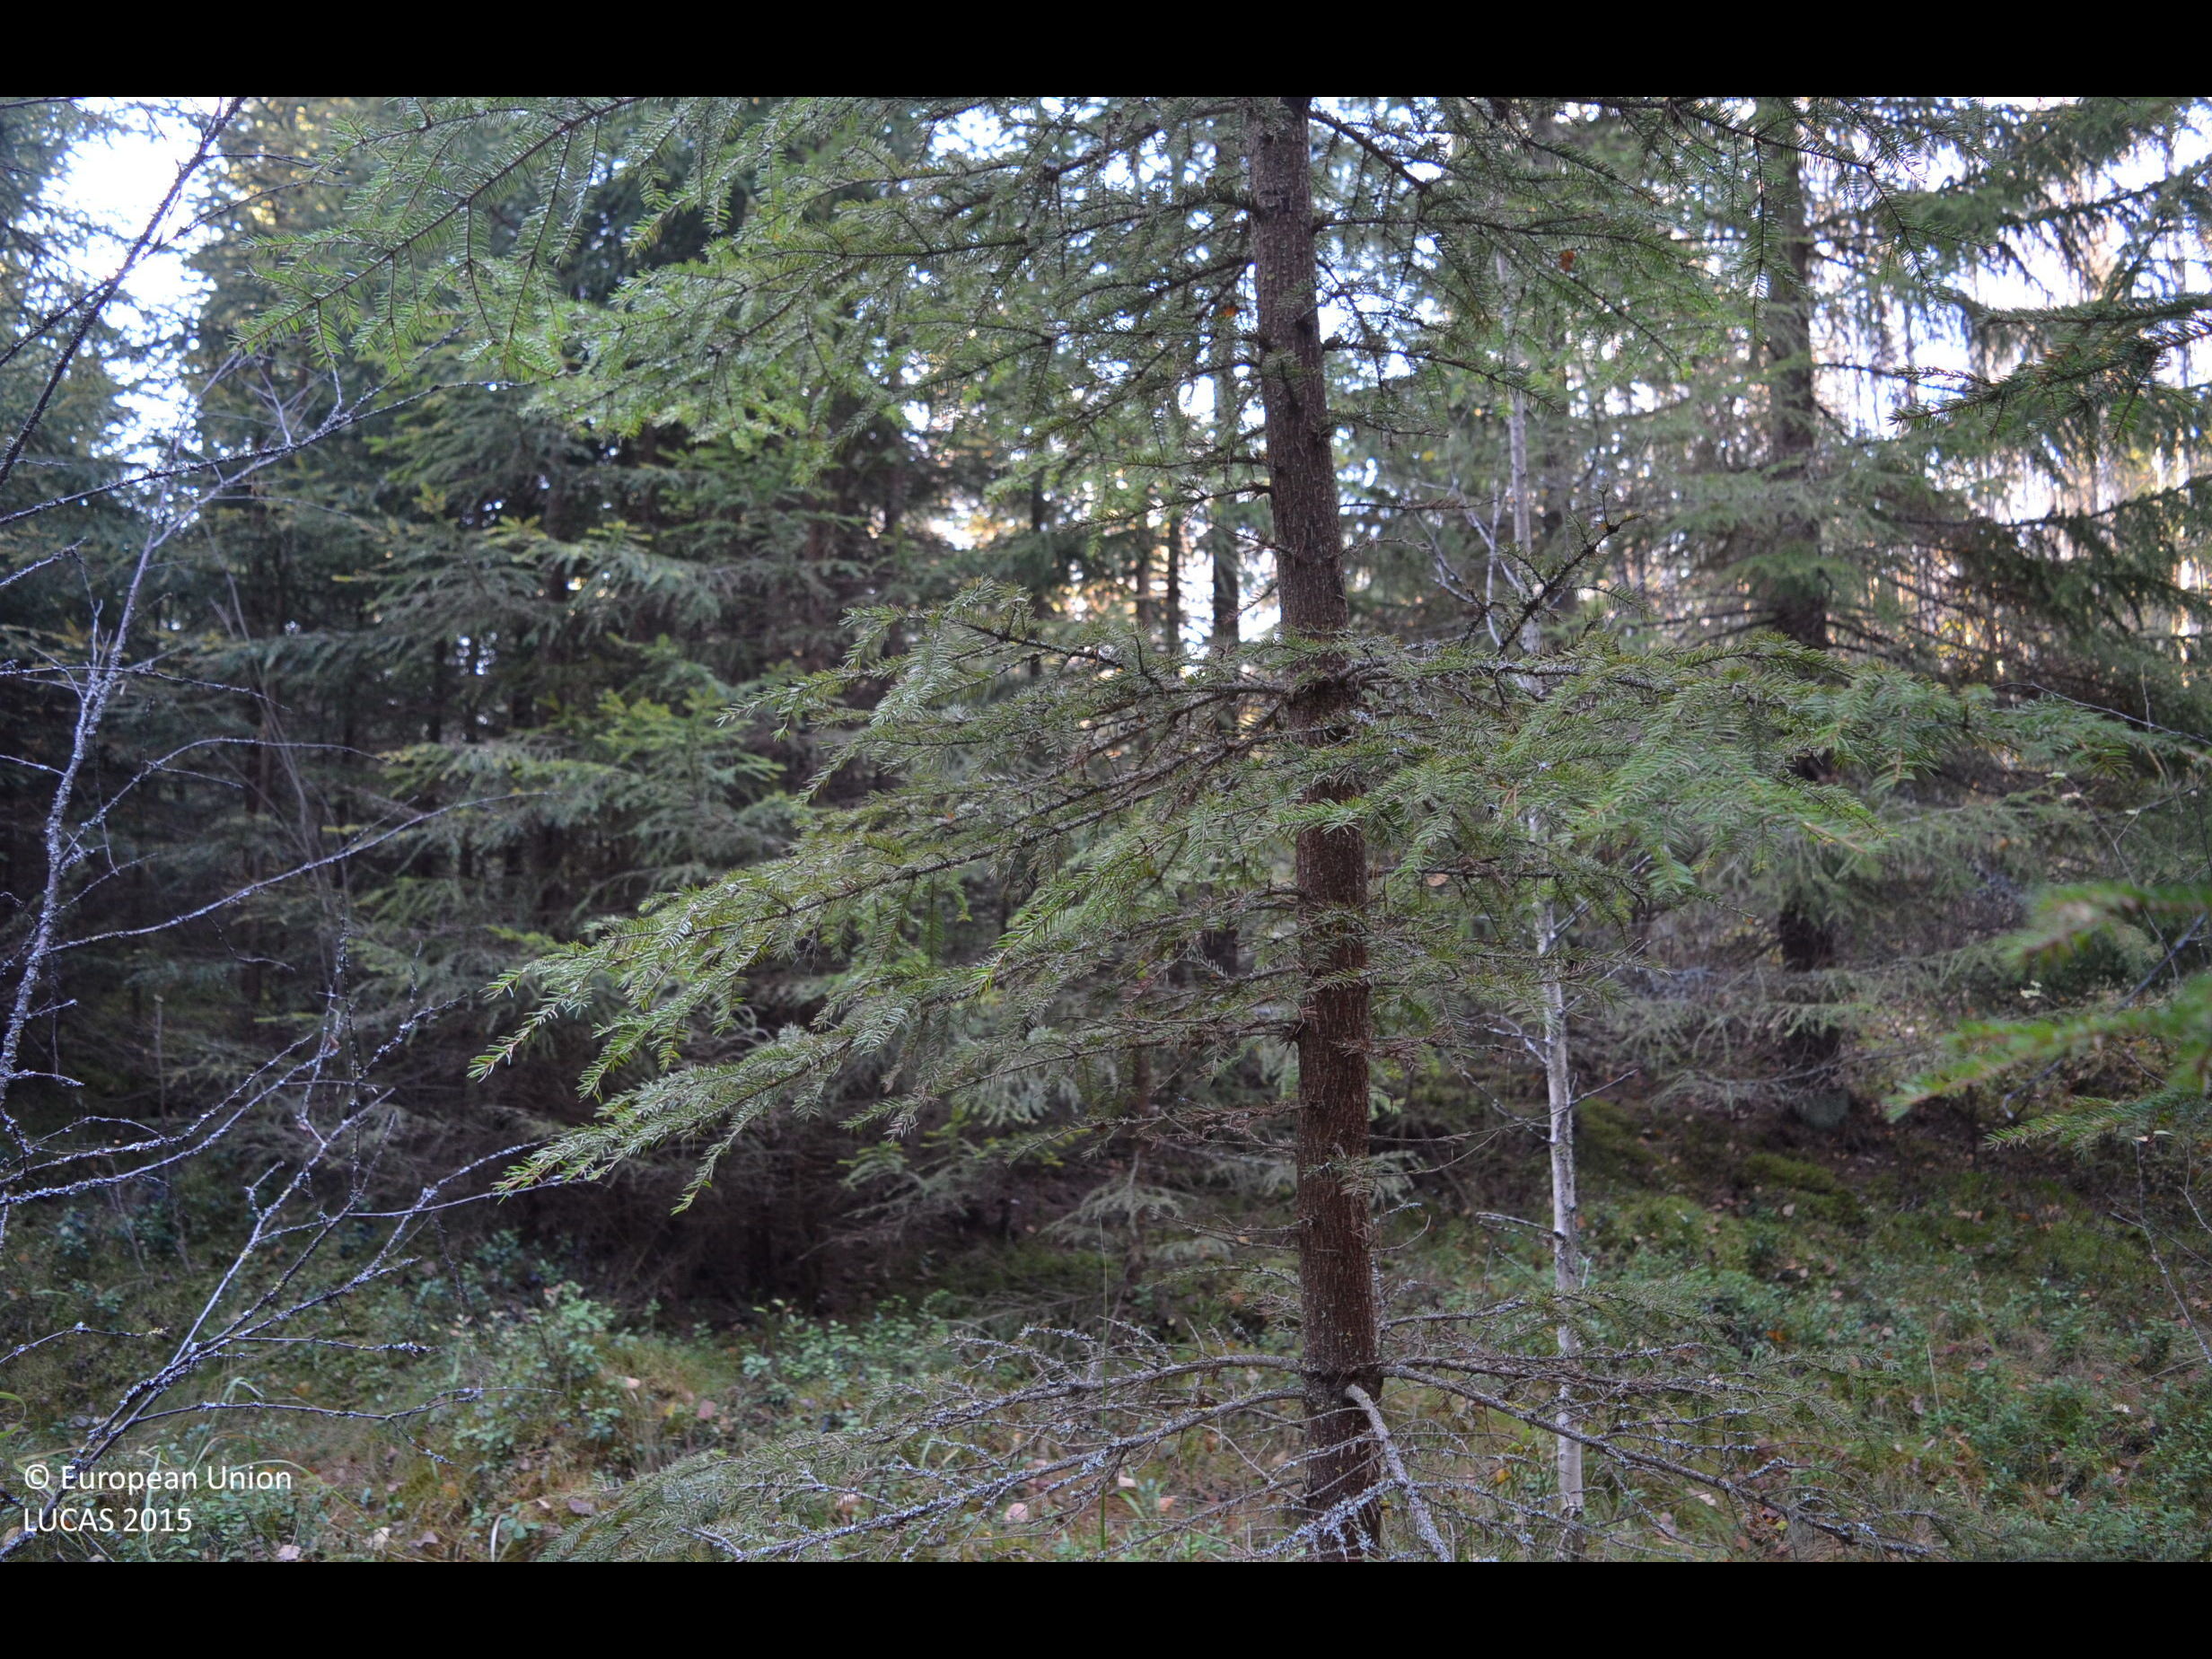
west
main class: Woodland
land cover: Spruce dominated coniferous woodland
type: boreal forest
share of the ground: > 75 %
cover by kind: coniferous forest trees 70 %, shrubs 15 %, broadleaved forest trees 10 %, lichens and mosses 5 %
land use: Forestry
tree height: > 5 m
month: October
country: FI
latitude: 61.7829
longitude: 23.8670
